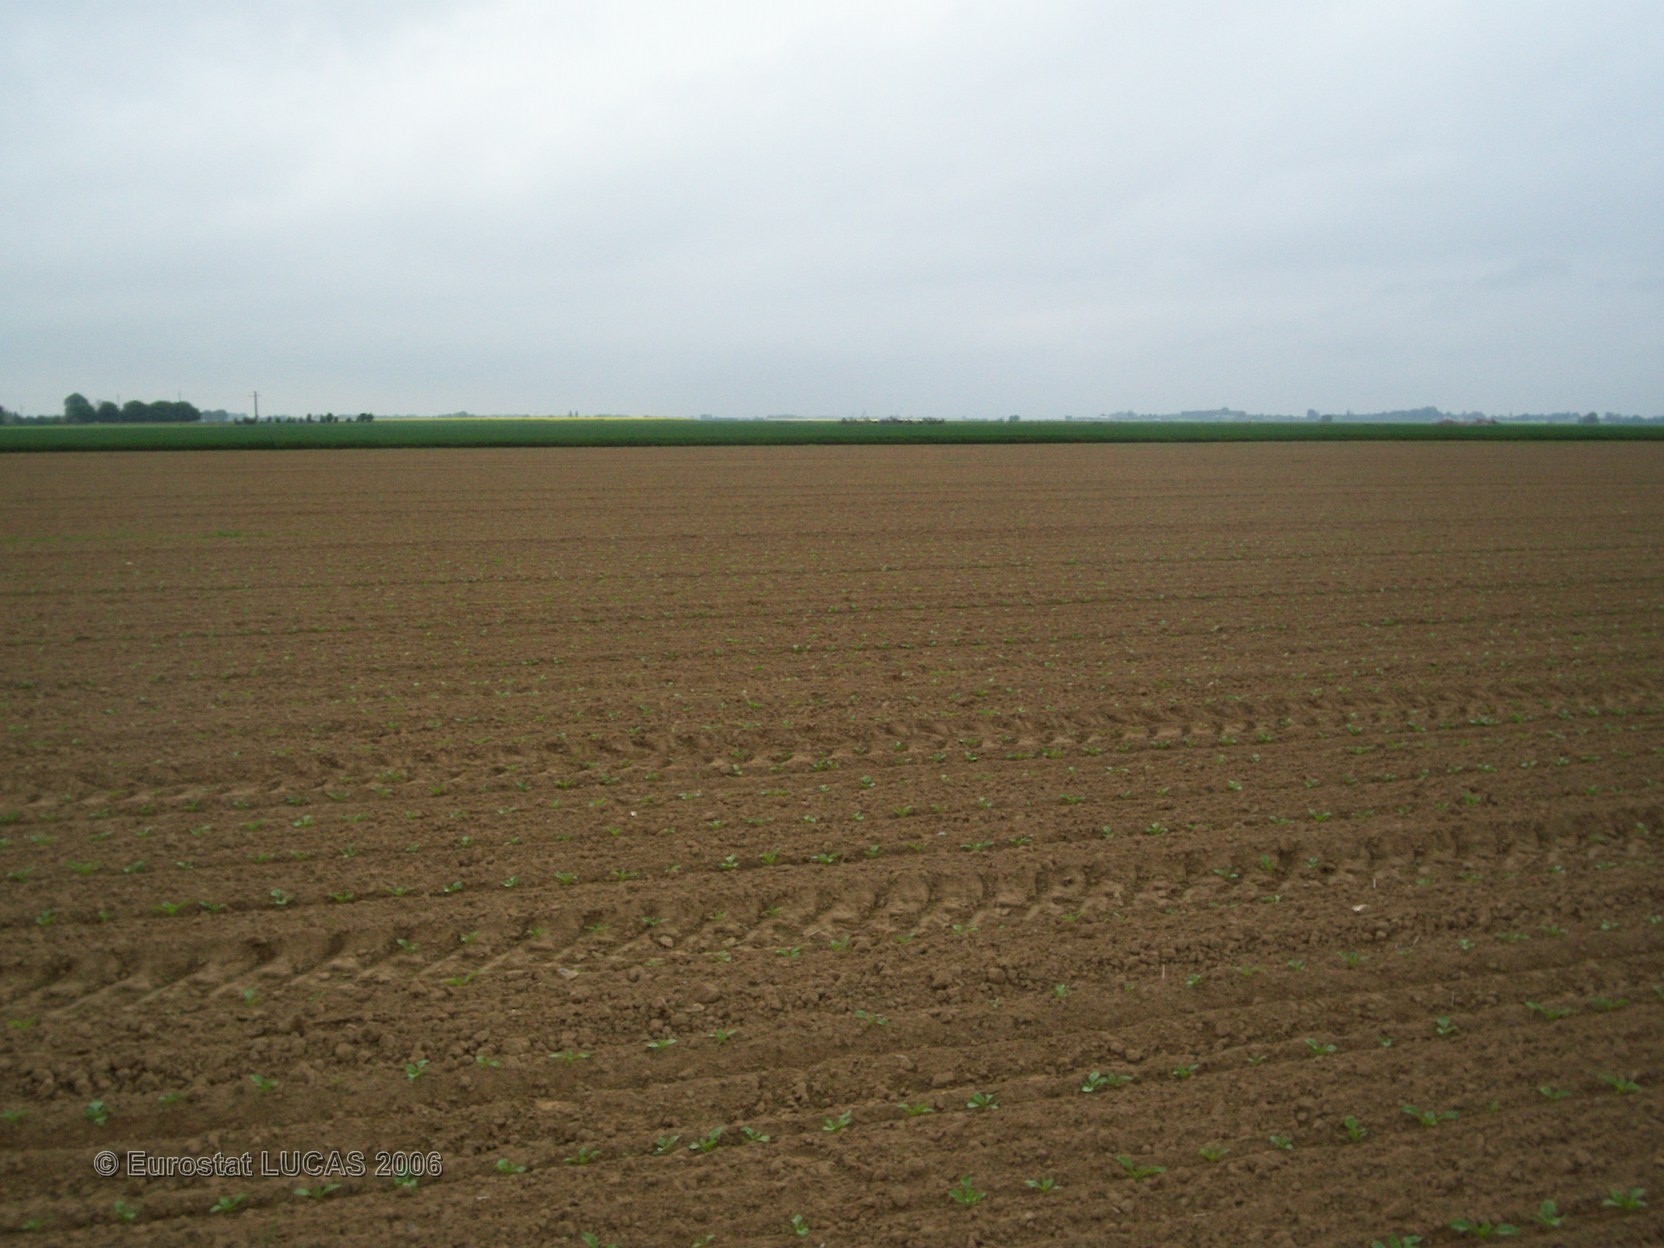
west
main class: Cropland
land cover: Sugar beet
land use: Agriculture (excluding fallow land and kitchen gardens)
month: May
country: FR
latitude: 49.1935
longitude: 0.9900
